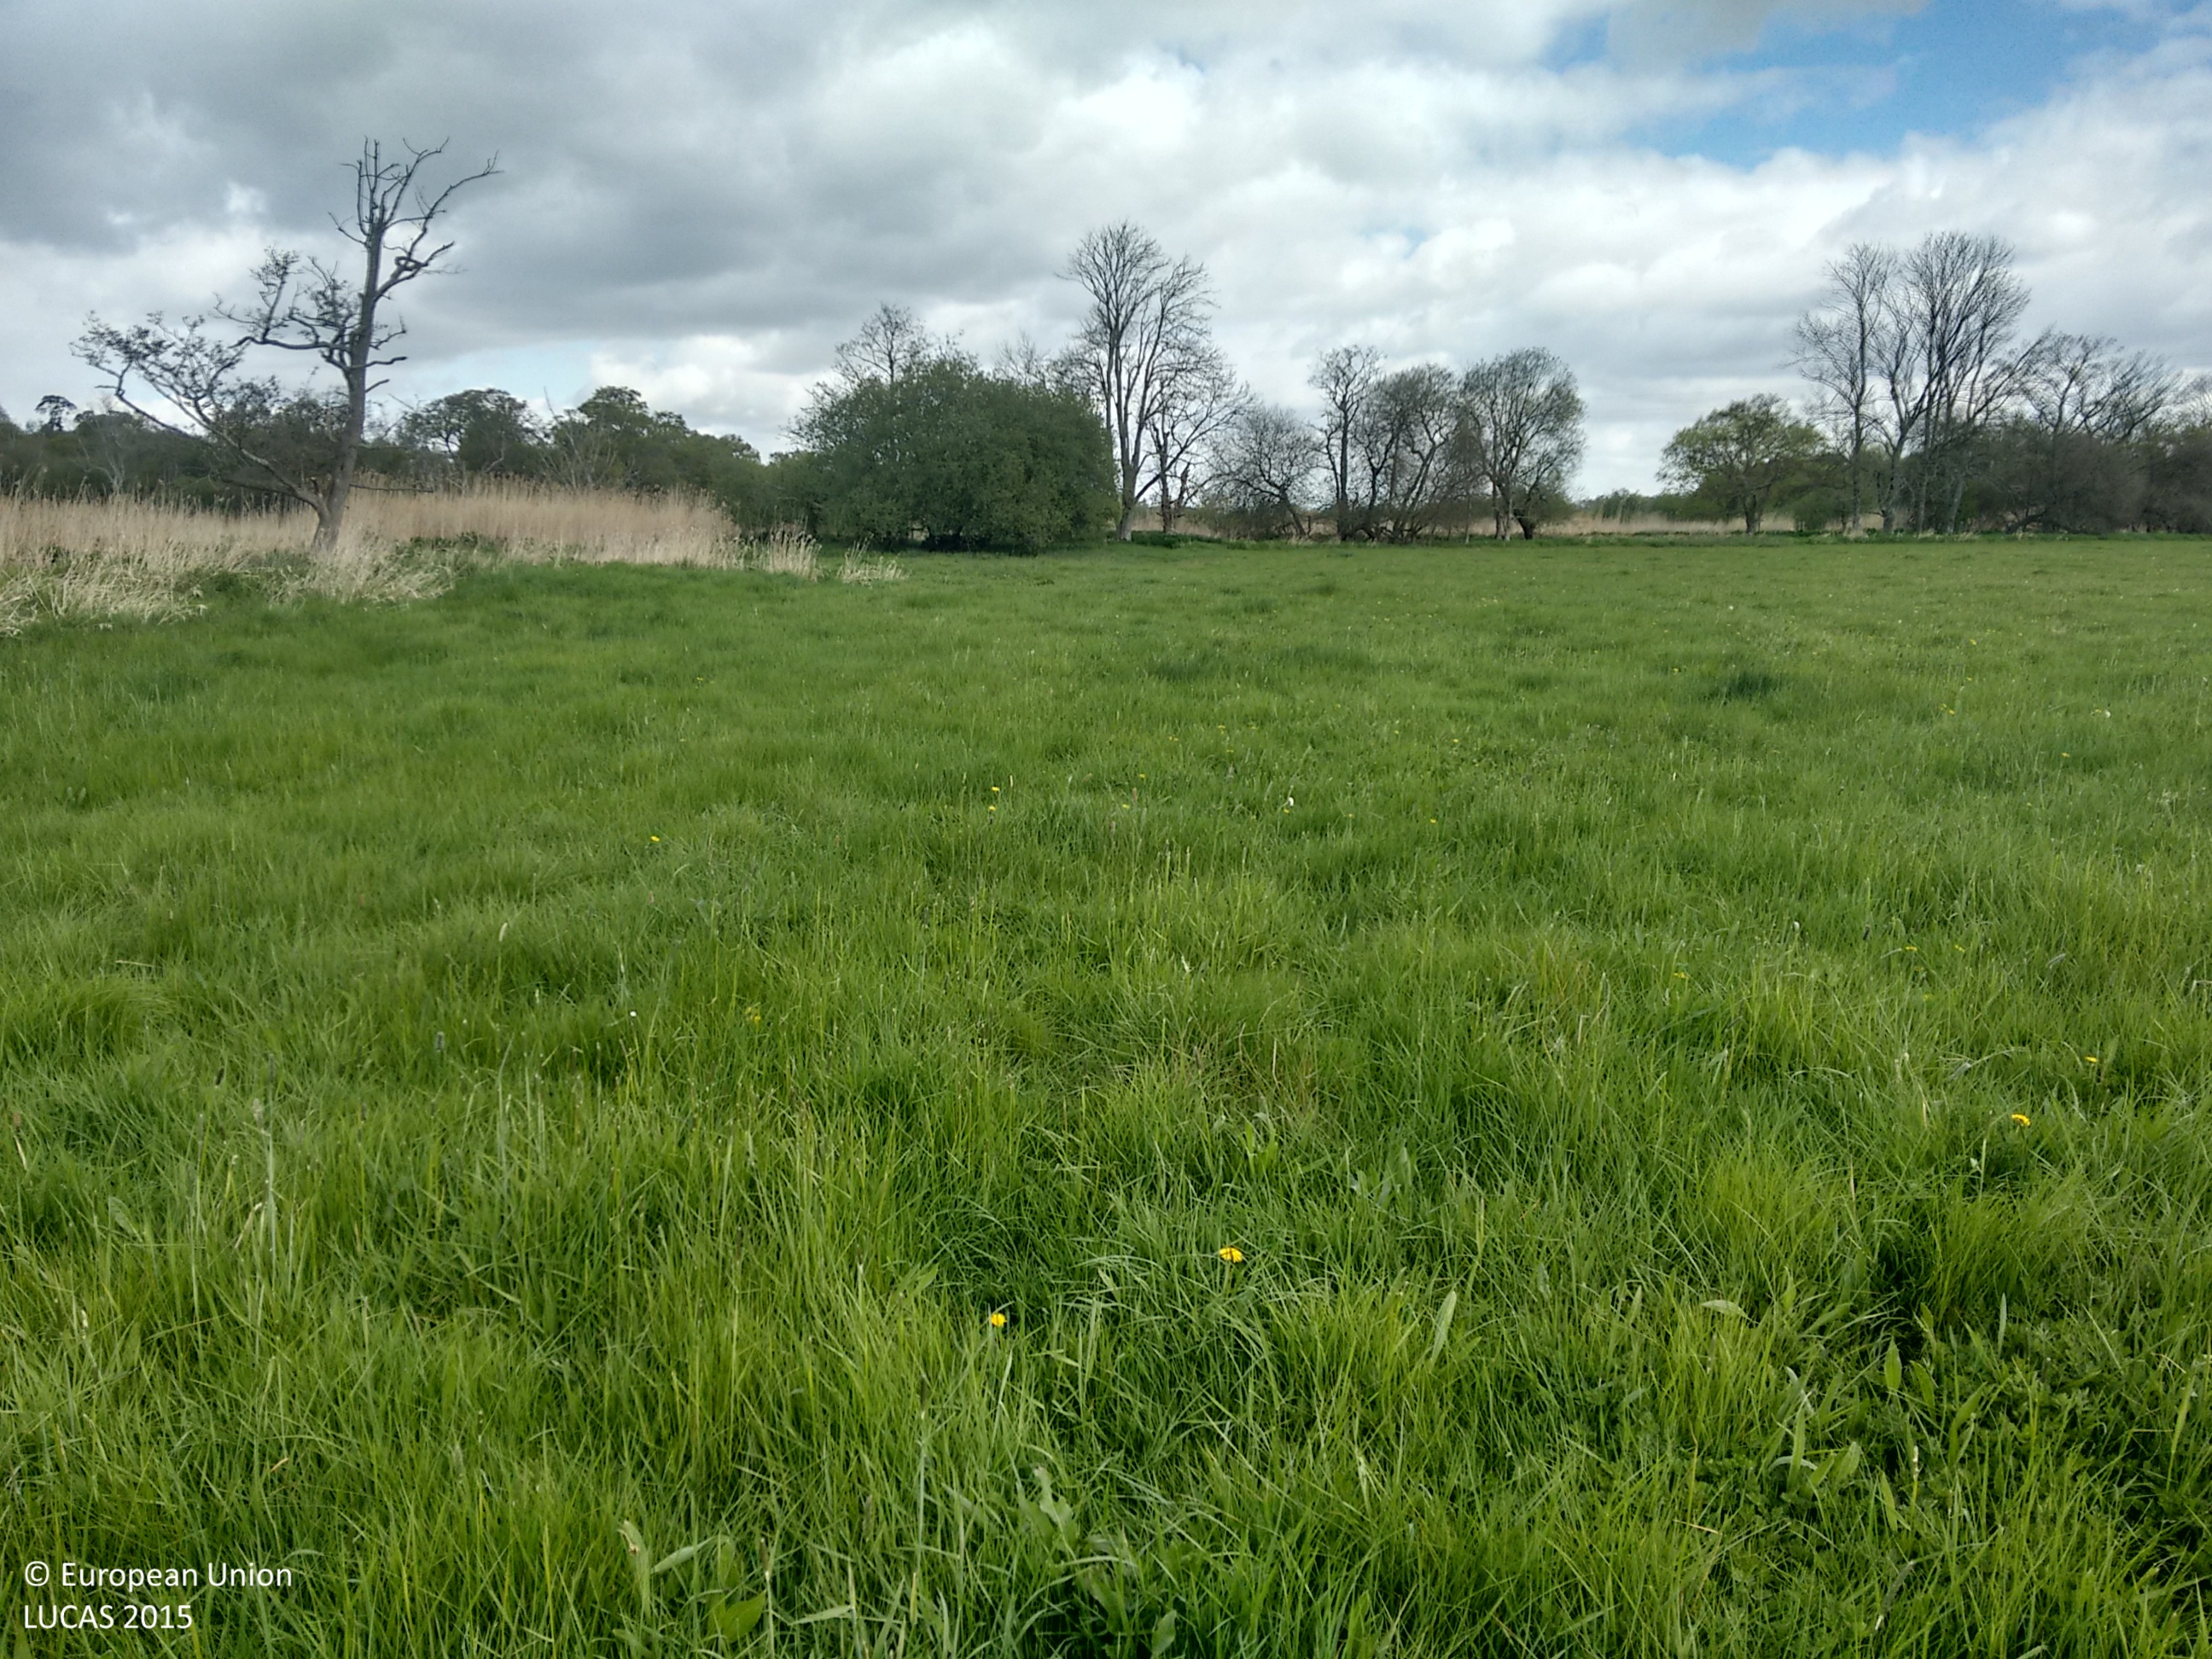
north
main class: Grassland
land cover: Grassland without tree/shrub cover
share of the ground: > 75 %
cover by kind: herbaceous plants 100 %
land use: Agriculture (excluding fallow land and kitchen gardens)
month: April
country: GB
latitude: 50.8591
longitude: -1.8042
